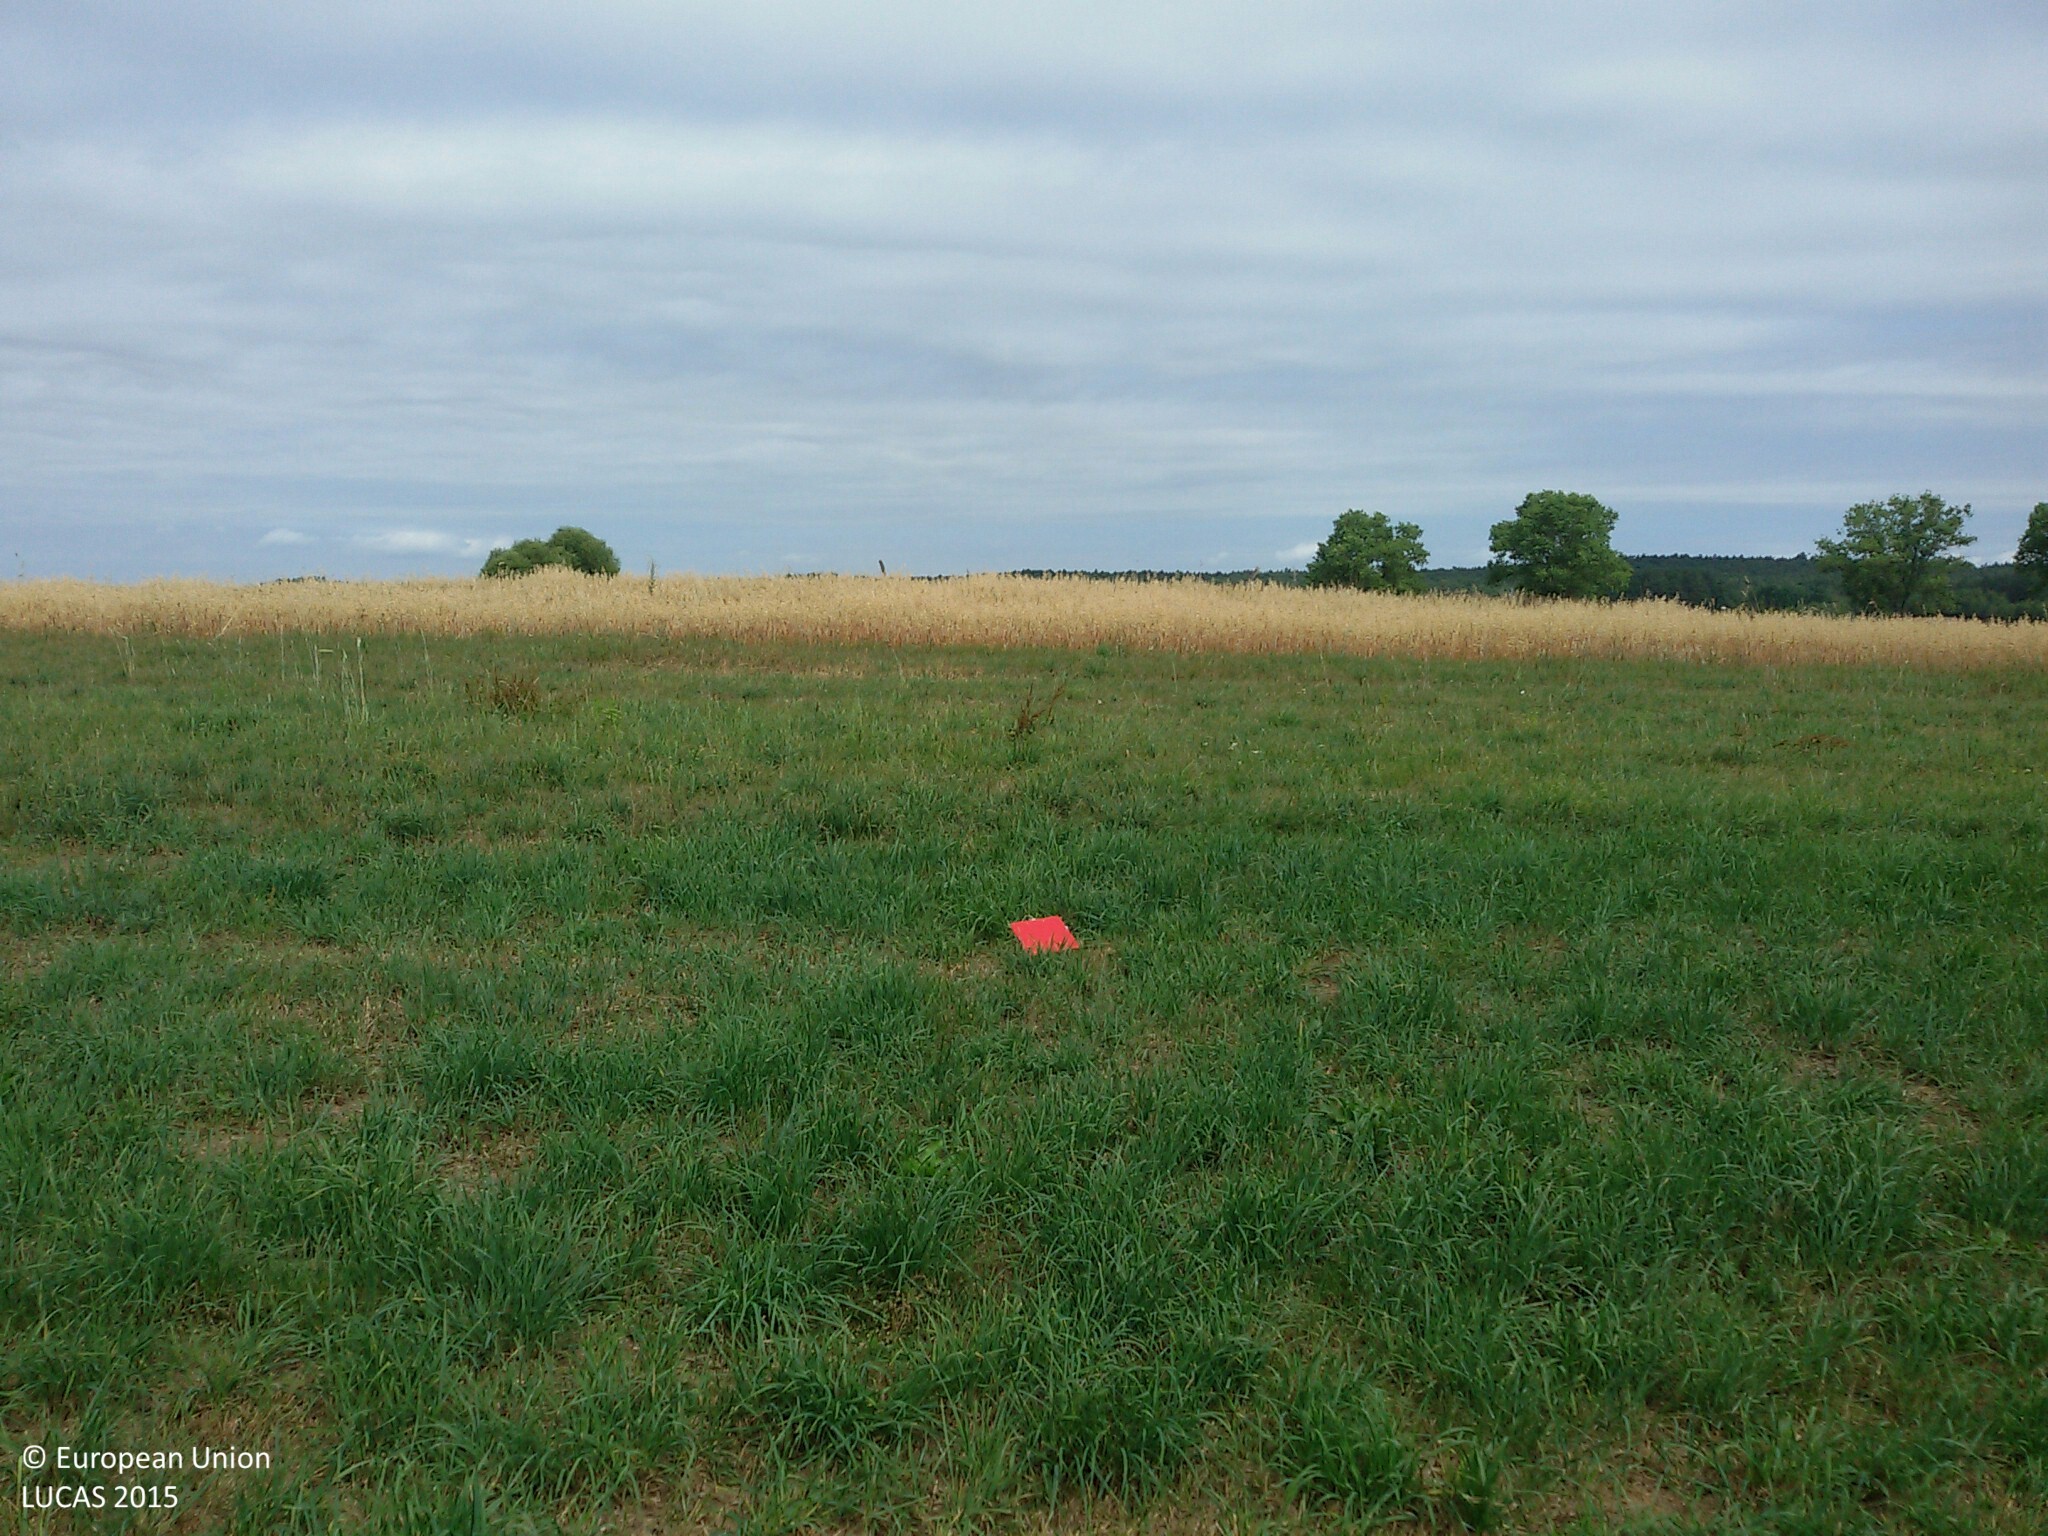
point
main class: Grassland
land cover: Grassland without tree/shrub cover
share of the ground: > 75 %
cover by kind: herbaceous plants 100 %
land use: Agriculture (excluding fallow land and kitchen gardens)
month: July
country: PL
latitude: 53.0661
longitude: 20.1367
